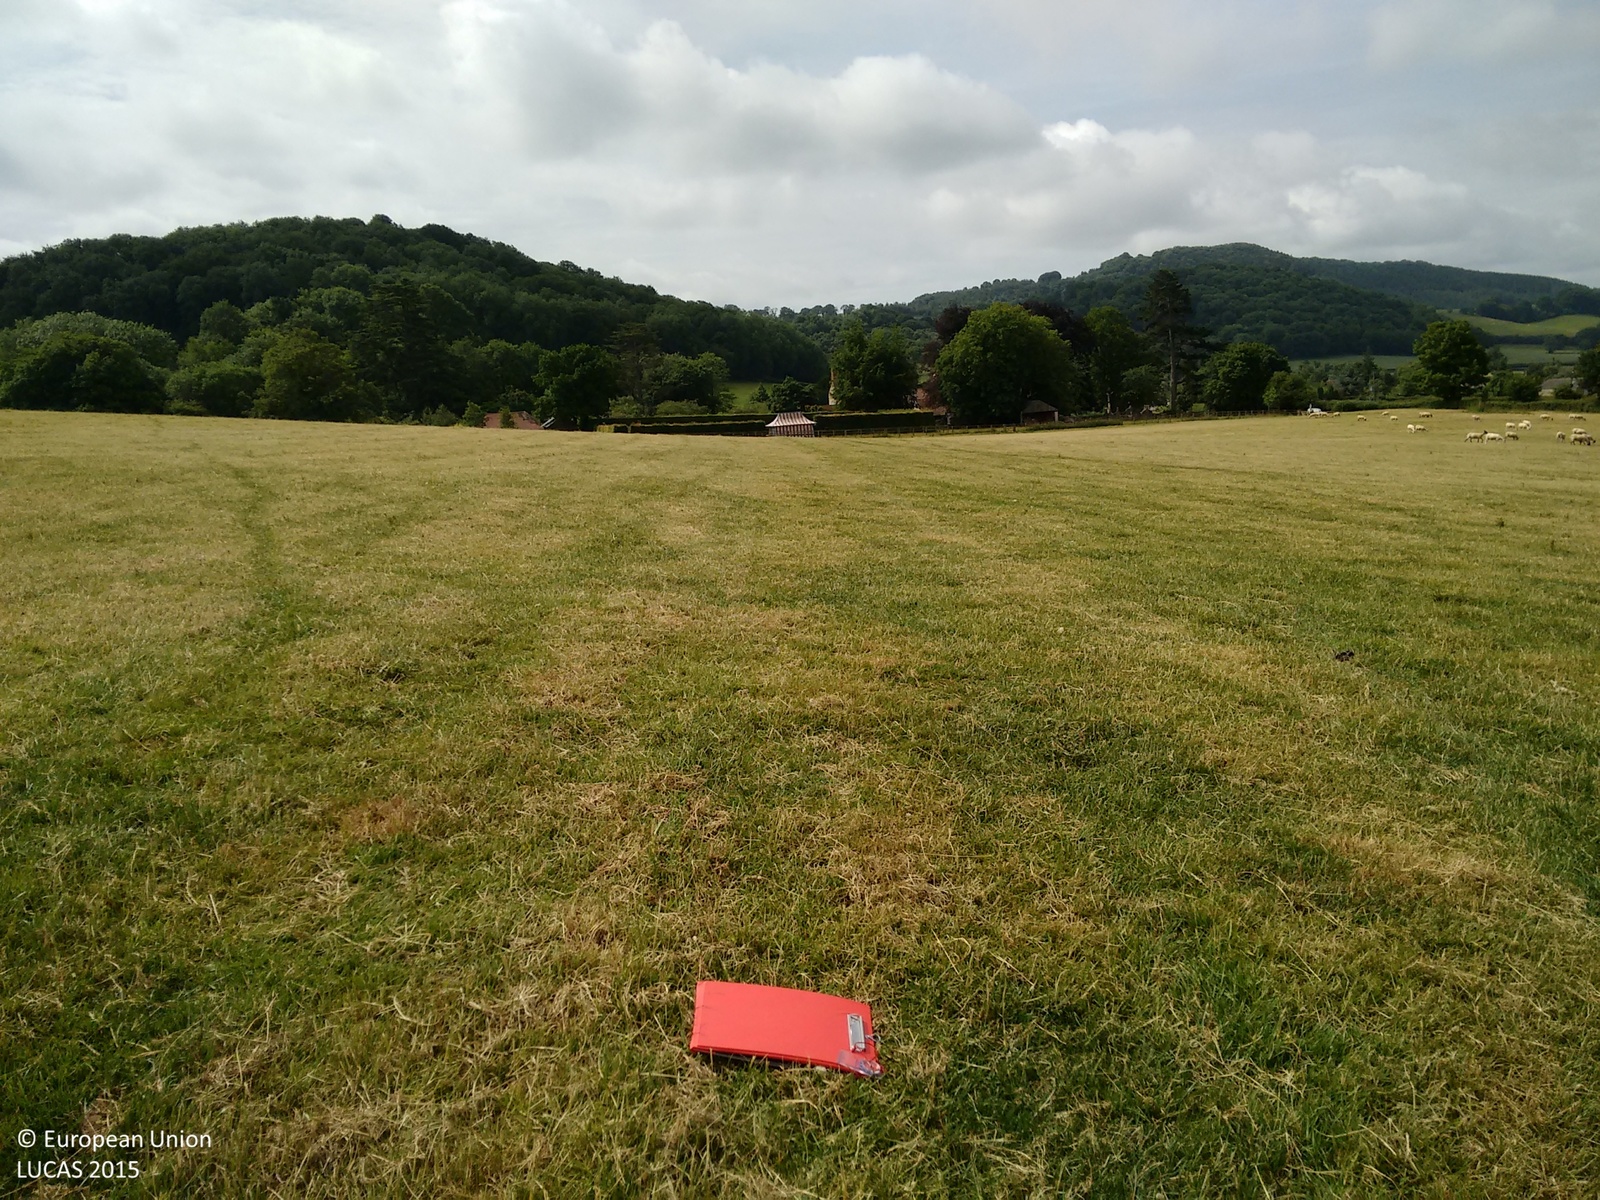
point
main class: Grassland
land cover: Grassland without tree/shrub cover
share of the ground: > 75 %
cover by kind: herbaceous plants 100 %
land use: Agriculture (excluding fallow land and kitchen gardens)
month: June
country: GB
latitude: 52.3370
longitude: -2.7959
